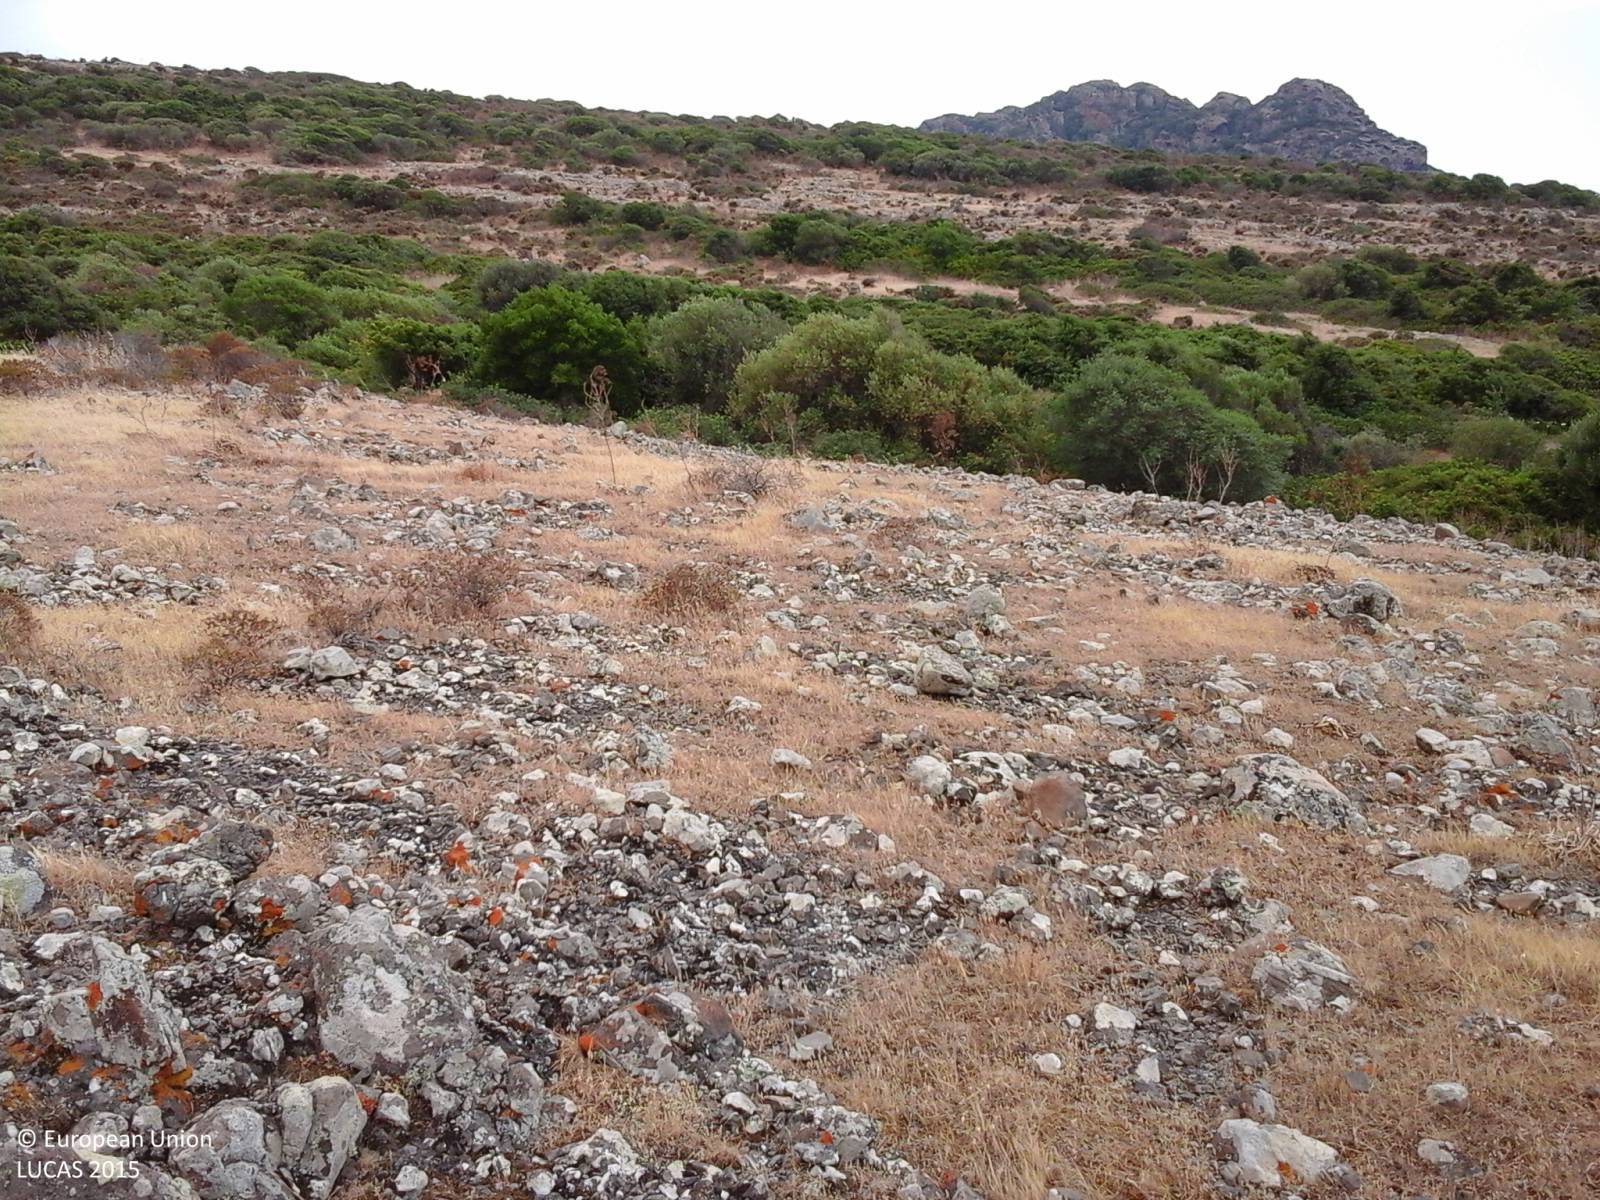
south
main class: Shrubland
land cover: Shrubland without tree cover
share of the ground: 50 - 75 %
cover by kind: consolidated bare surface 50 %, herbaceous plants 30 %, shrubs 20 %
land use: Semi-natural and natural areas not in use
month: June
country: IT
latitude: 39.6771
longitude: 8.5510
